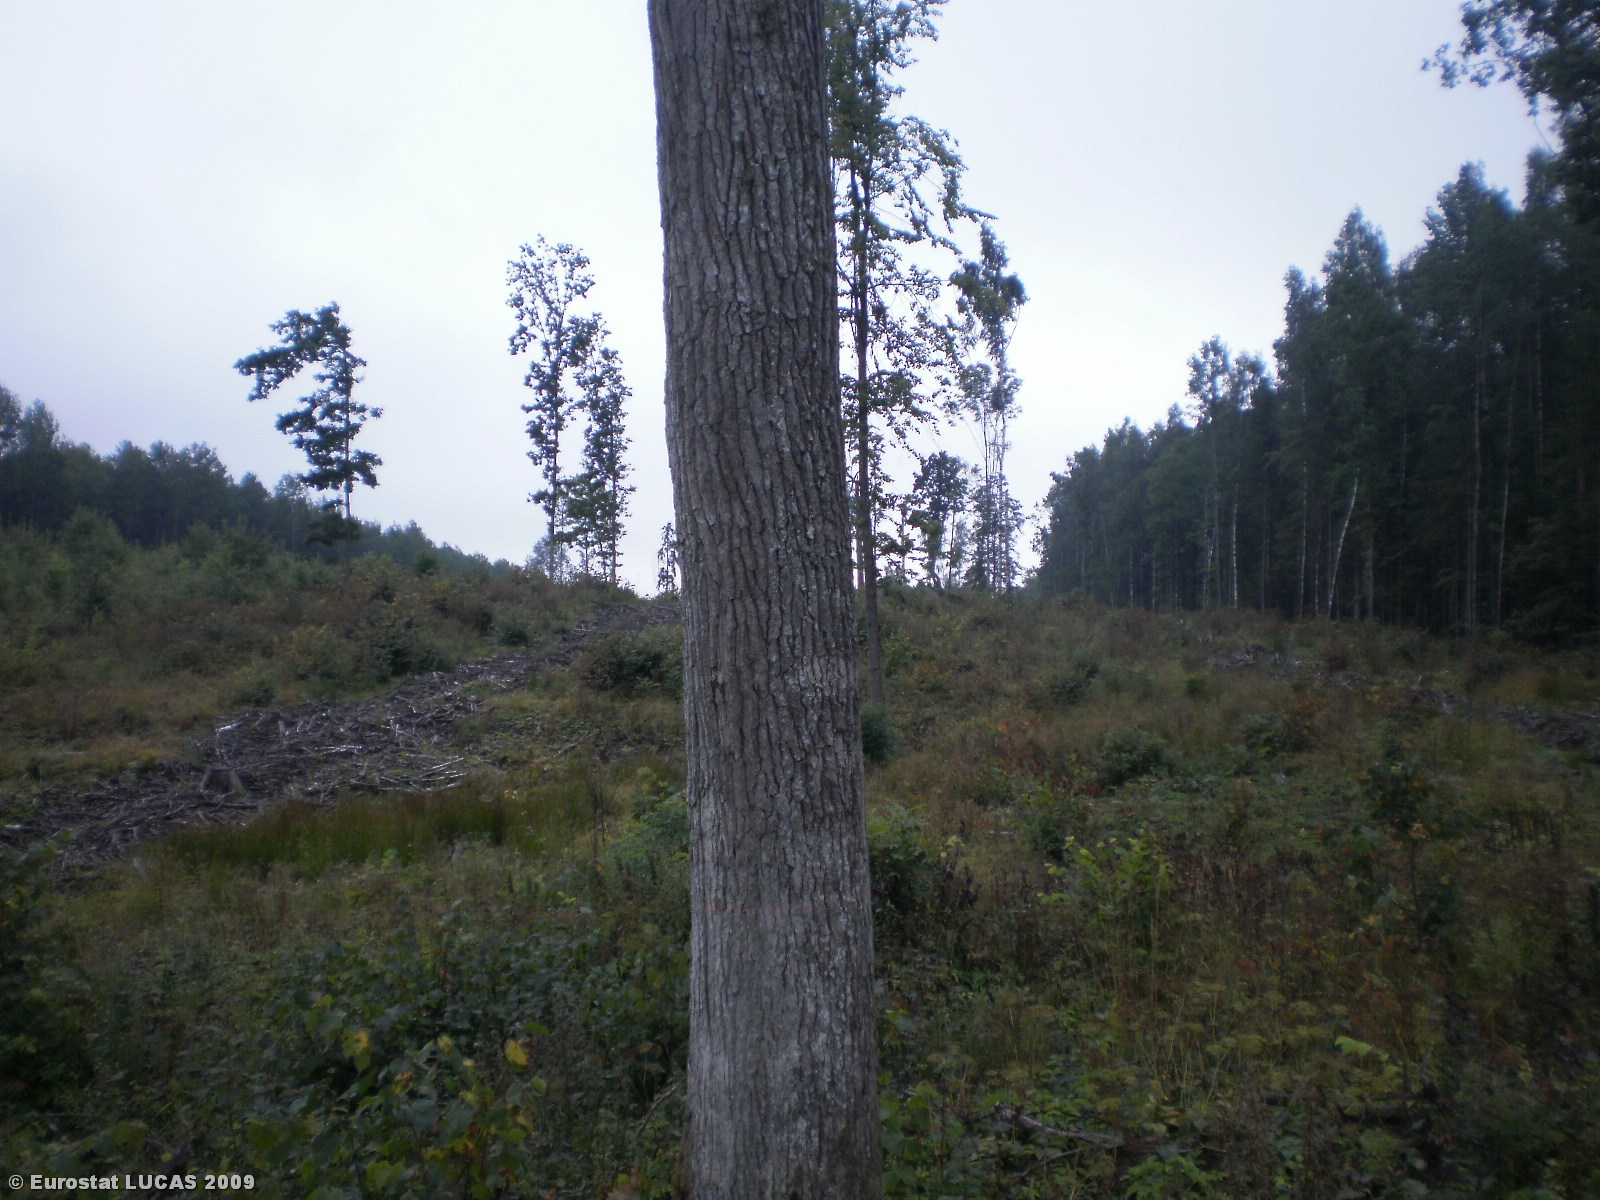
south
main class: Shrubland
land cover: Shrubland with sparse tree cover
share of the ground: > 75 %
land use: Forestry
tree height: > 5 m
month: August
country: LT
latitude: 55.1414
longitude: 25.3874
